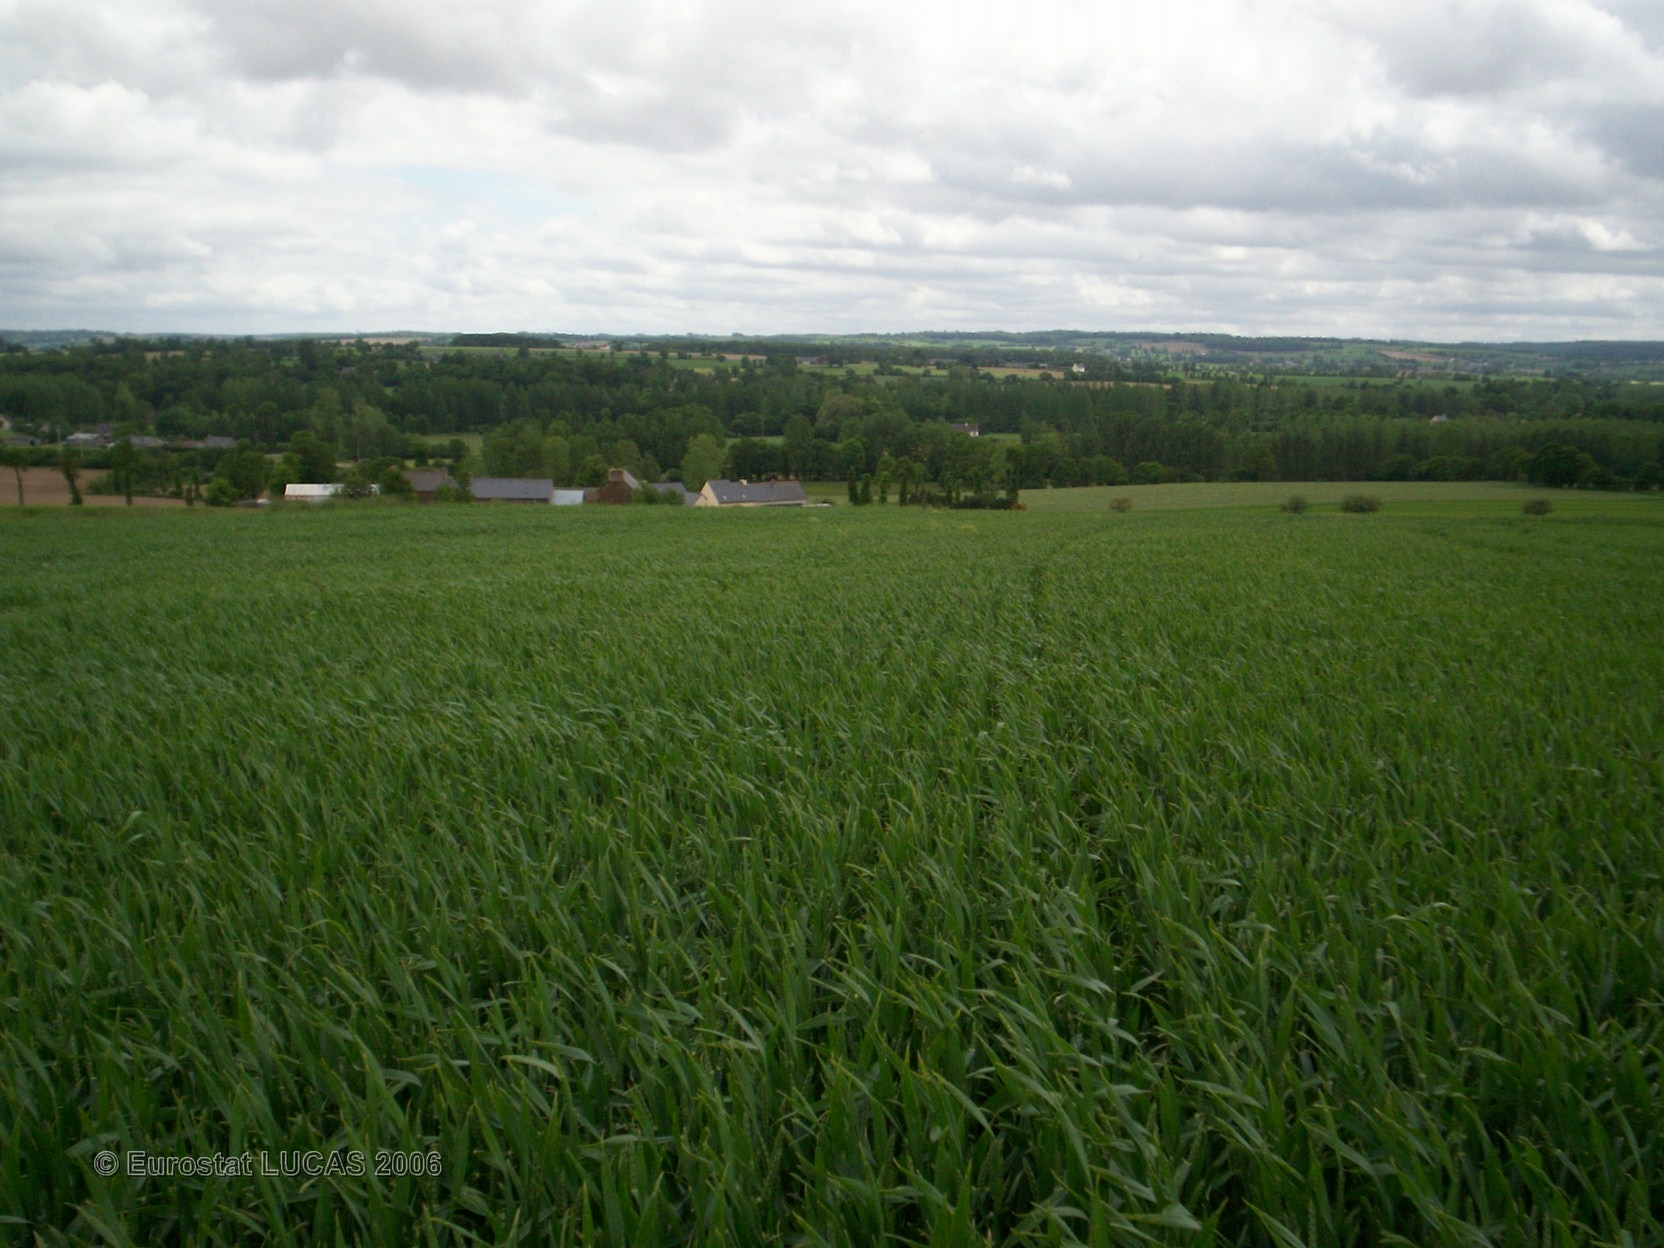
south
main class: Cropland
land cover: Common wheat
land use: Agriculture (excluding fallow land and kitchen gardens)
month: May
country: FR
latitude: 48.3774
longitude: -2.3860
